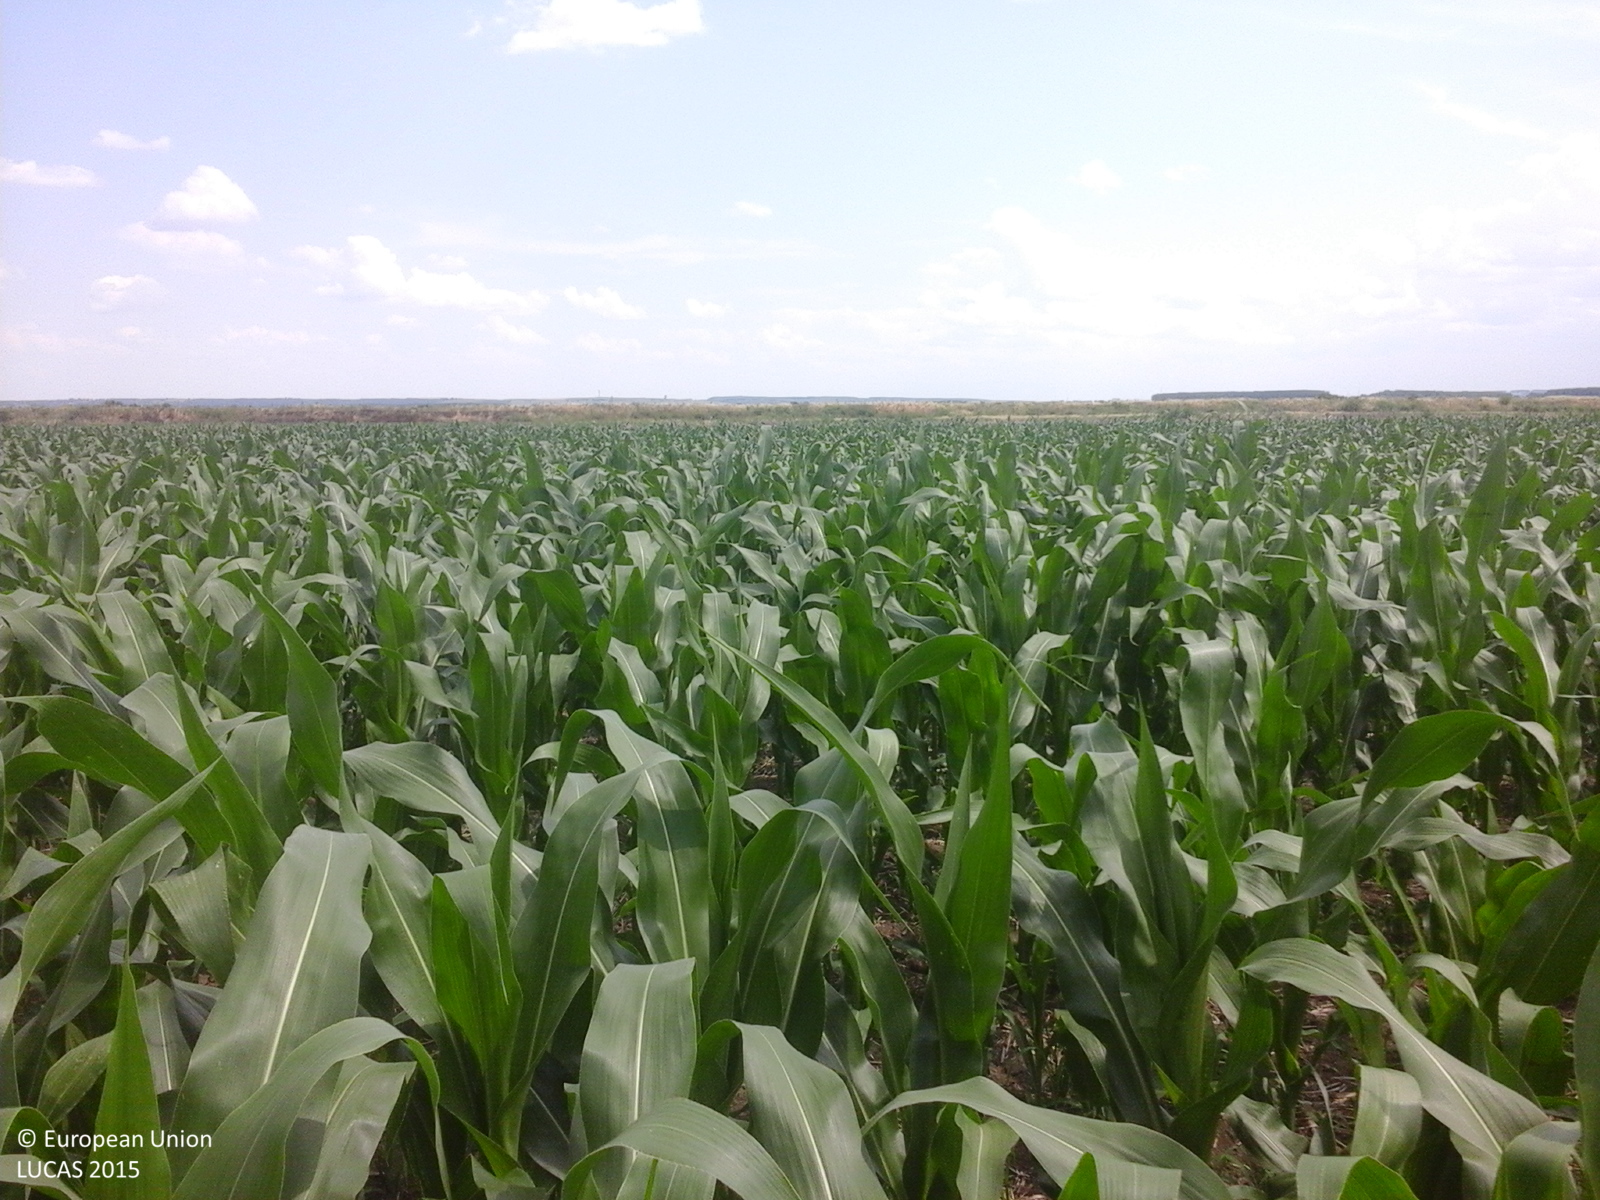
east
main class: Cropland
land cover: Maize
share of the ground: > 75 %
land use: Agriculture (excluding fallow land and kitchen gardens)
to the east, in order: Maize; Spontaneously vegetated surfaces; Ditches and canals; Spontaneously vegetated surfaces; Maize
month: June
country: RO
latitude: 44.0832
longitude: 26.5086
